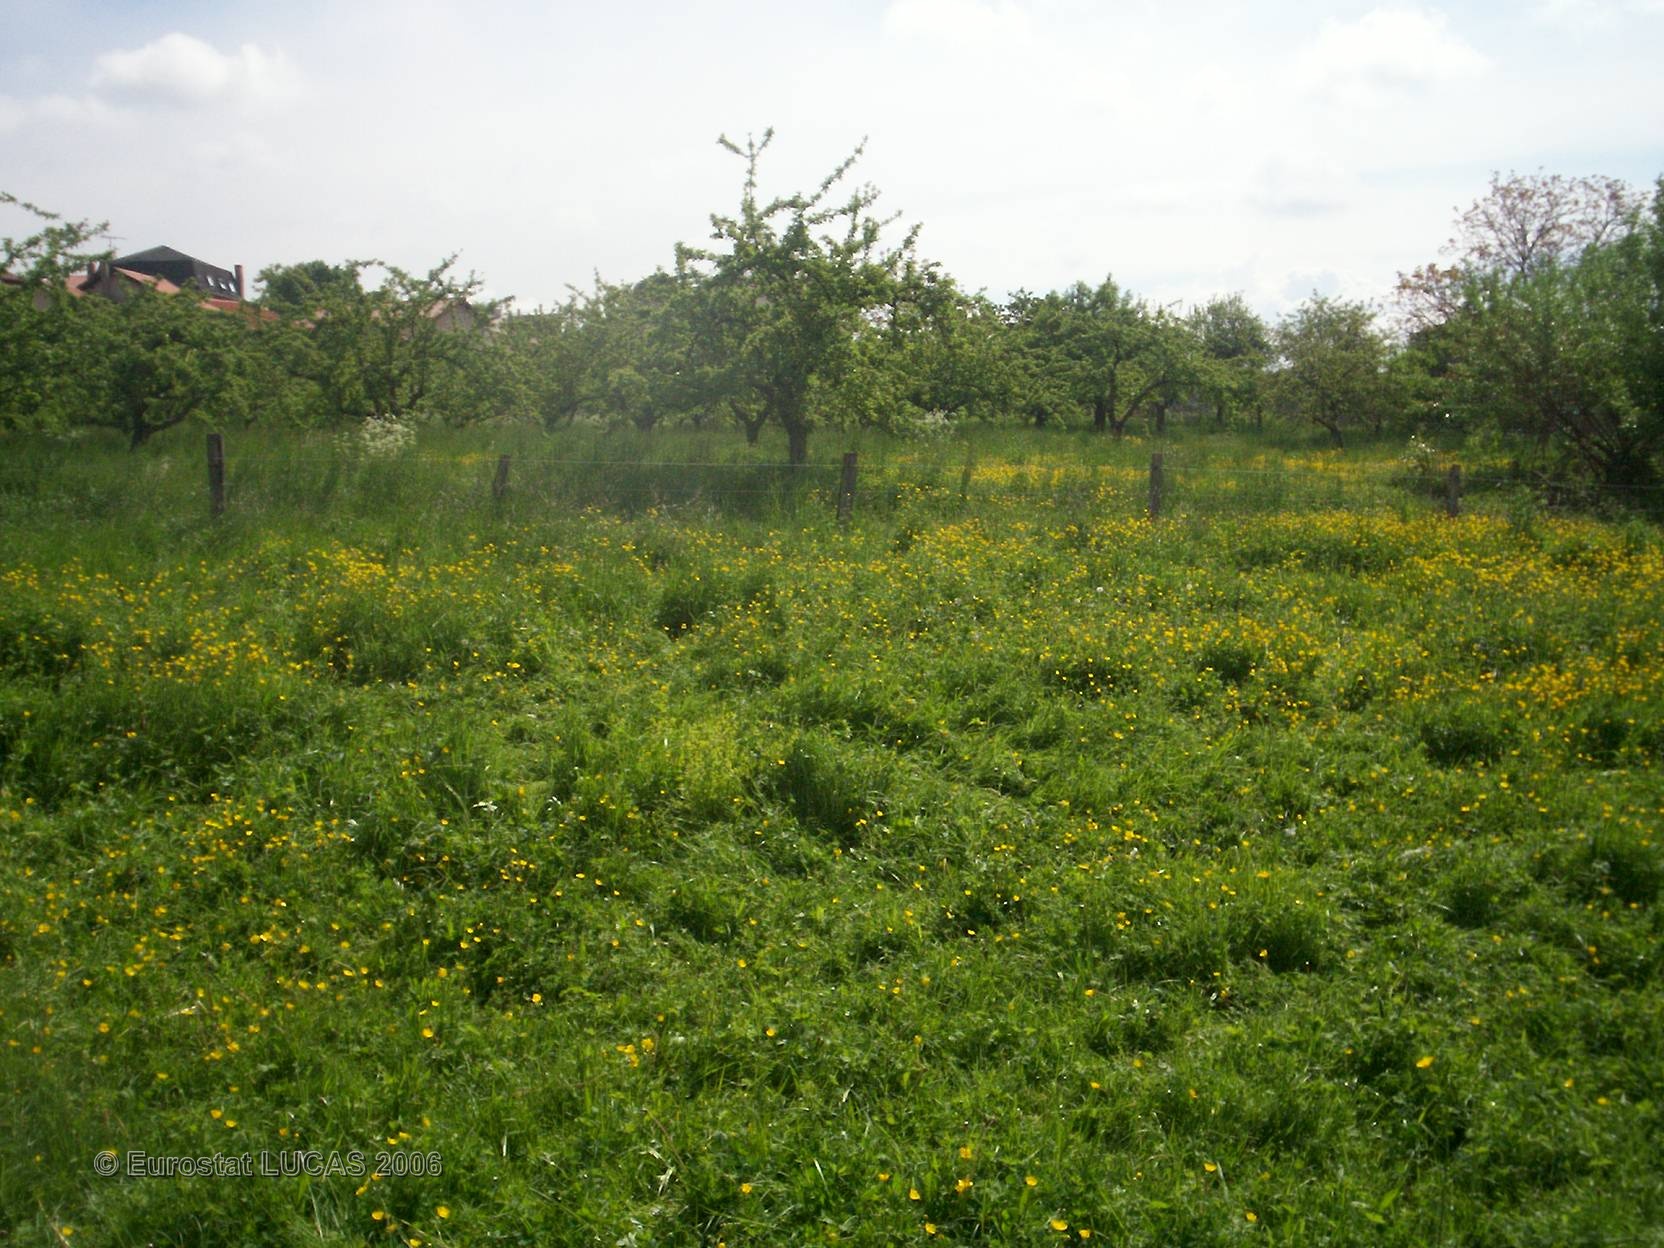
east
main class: Grassland
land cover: Grassland without tree/shrub cover
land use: Agriculture (excluding fallow land and kitchen gardens)
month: May
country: FR
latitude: 45.5529
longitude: 3.1475
